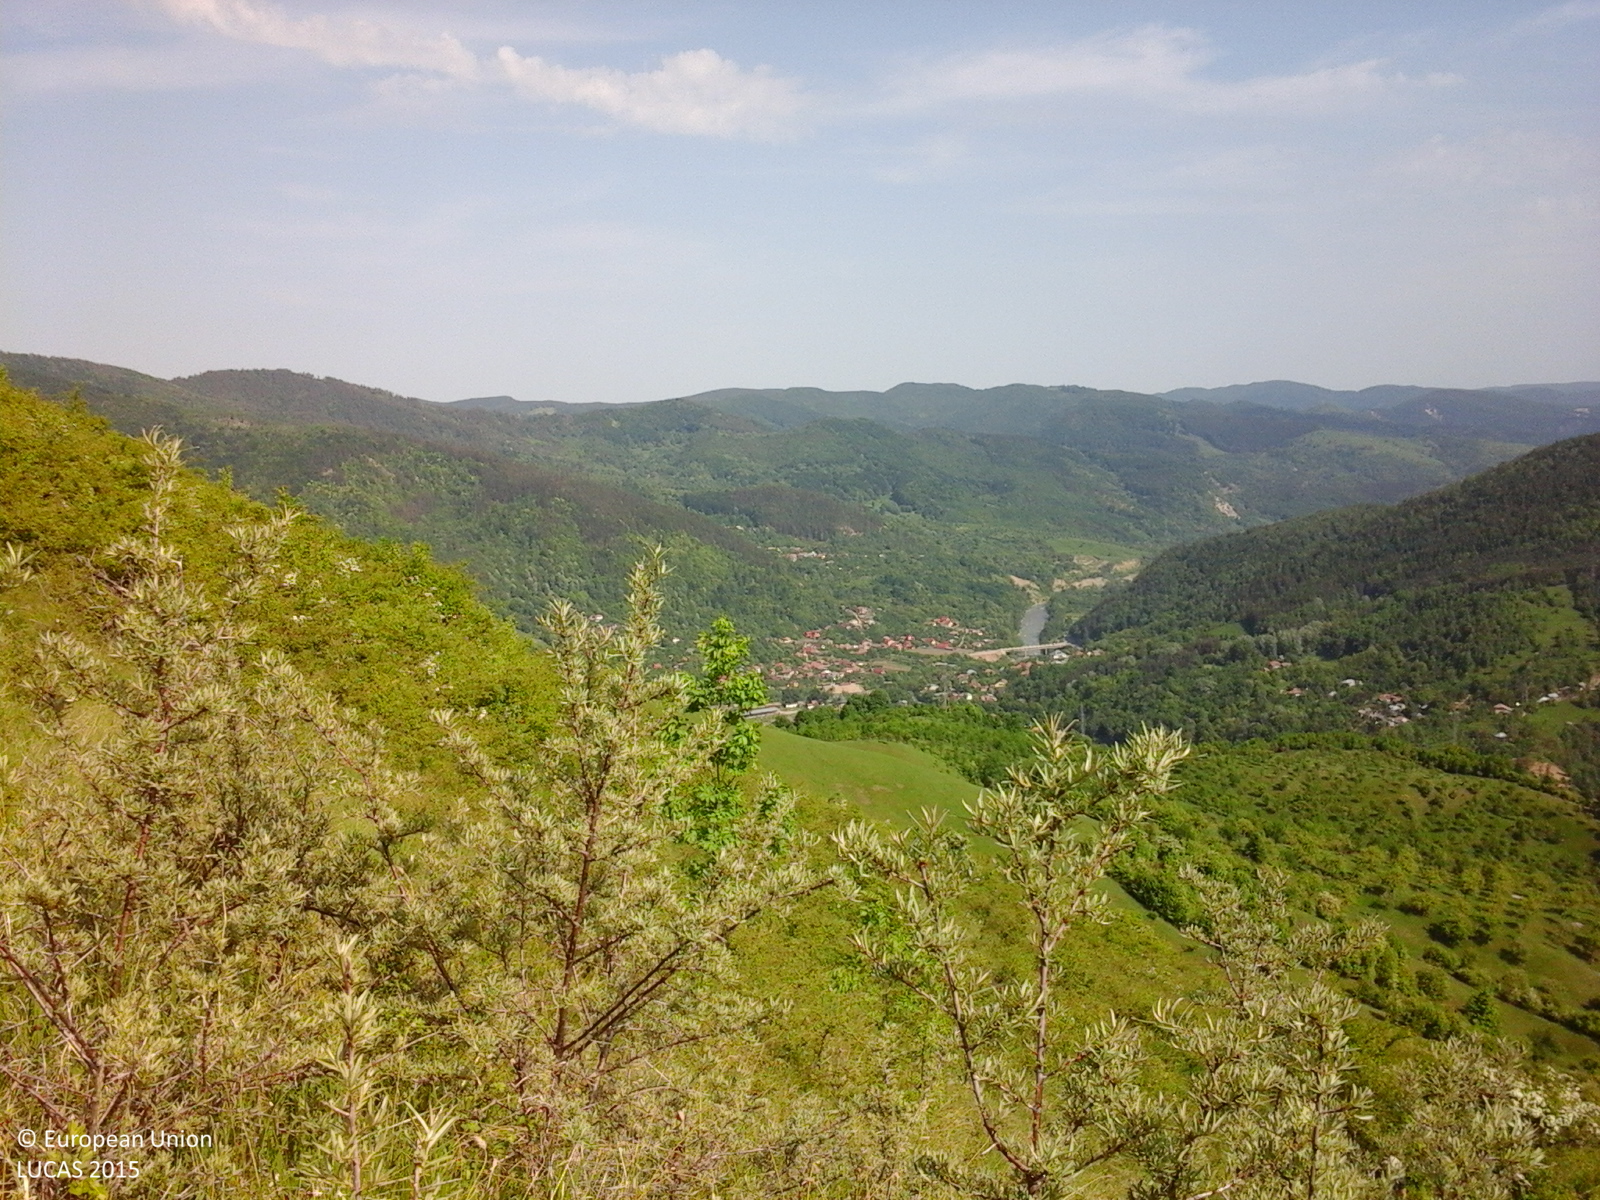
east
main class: Shrubland
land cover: Shrubland with sparse tree cover
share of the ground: > 75 %
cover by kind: shrubs 95 %, broadleaved forest trees 5 %
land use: Forestry
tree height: < 5 m
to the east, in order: Shrubland with sparse tree cover; Grassland with sparse tree/shrub cover; Grassland without tree/shrub cover
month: May
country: RO
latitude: 45.4228
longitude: 26.2862
